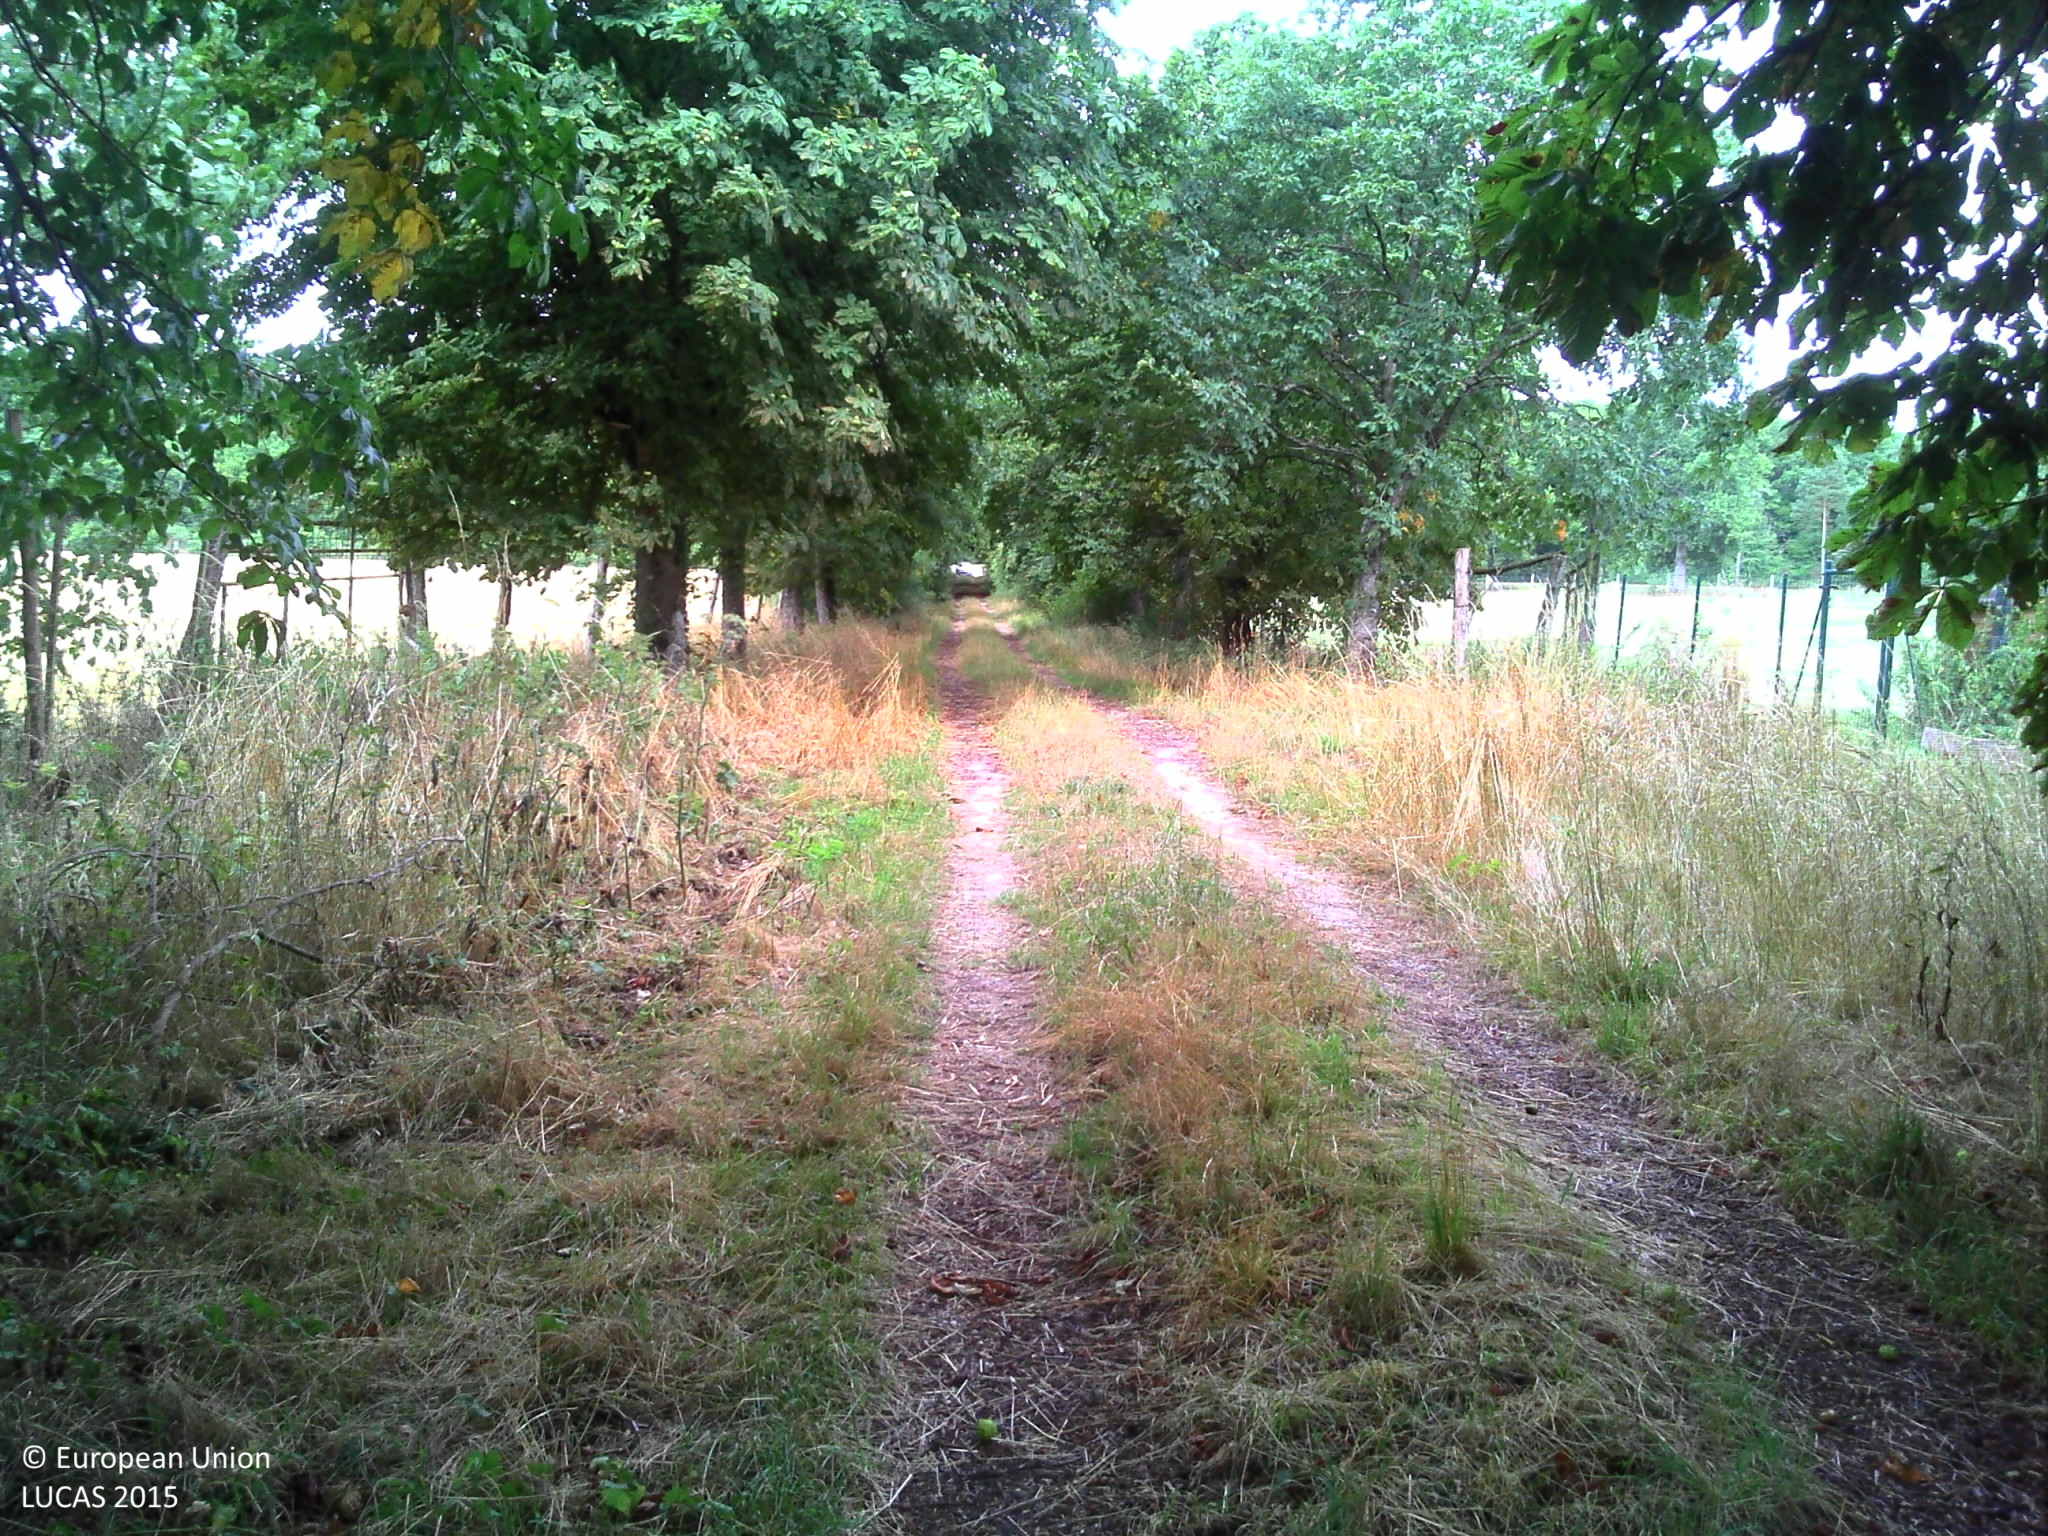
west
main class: Cropland
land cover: Arable land (only in case pi)
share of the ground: > 75 %
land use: Agriculture (excluding fallow land and kitchen gardens)
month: August
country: FR
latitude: 48.0038
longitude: 1.9857
